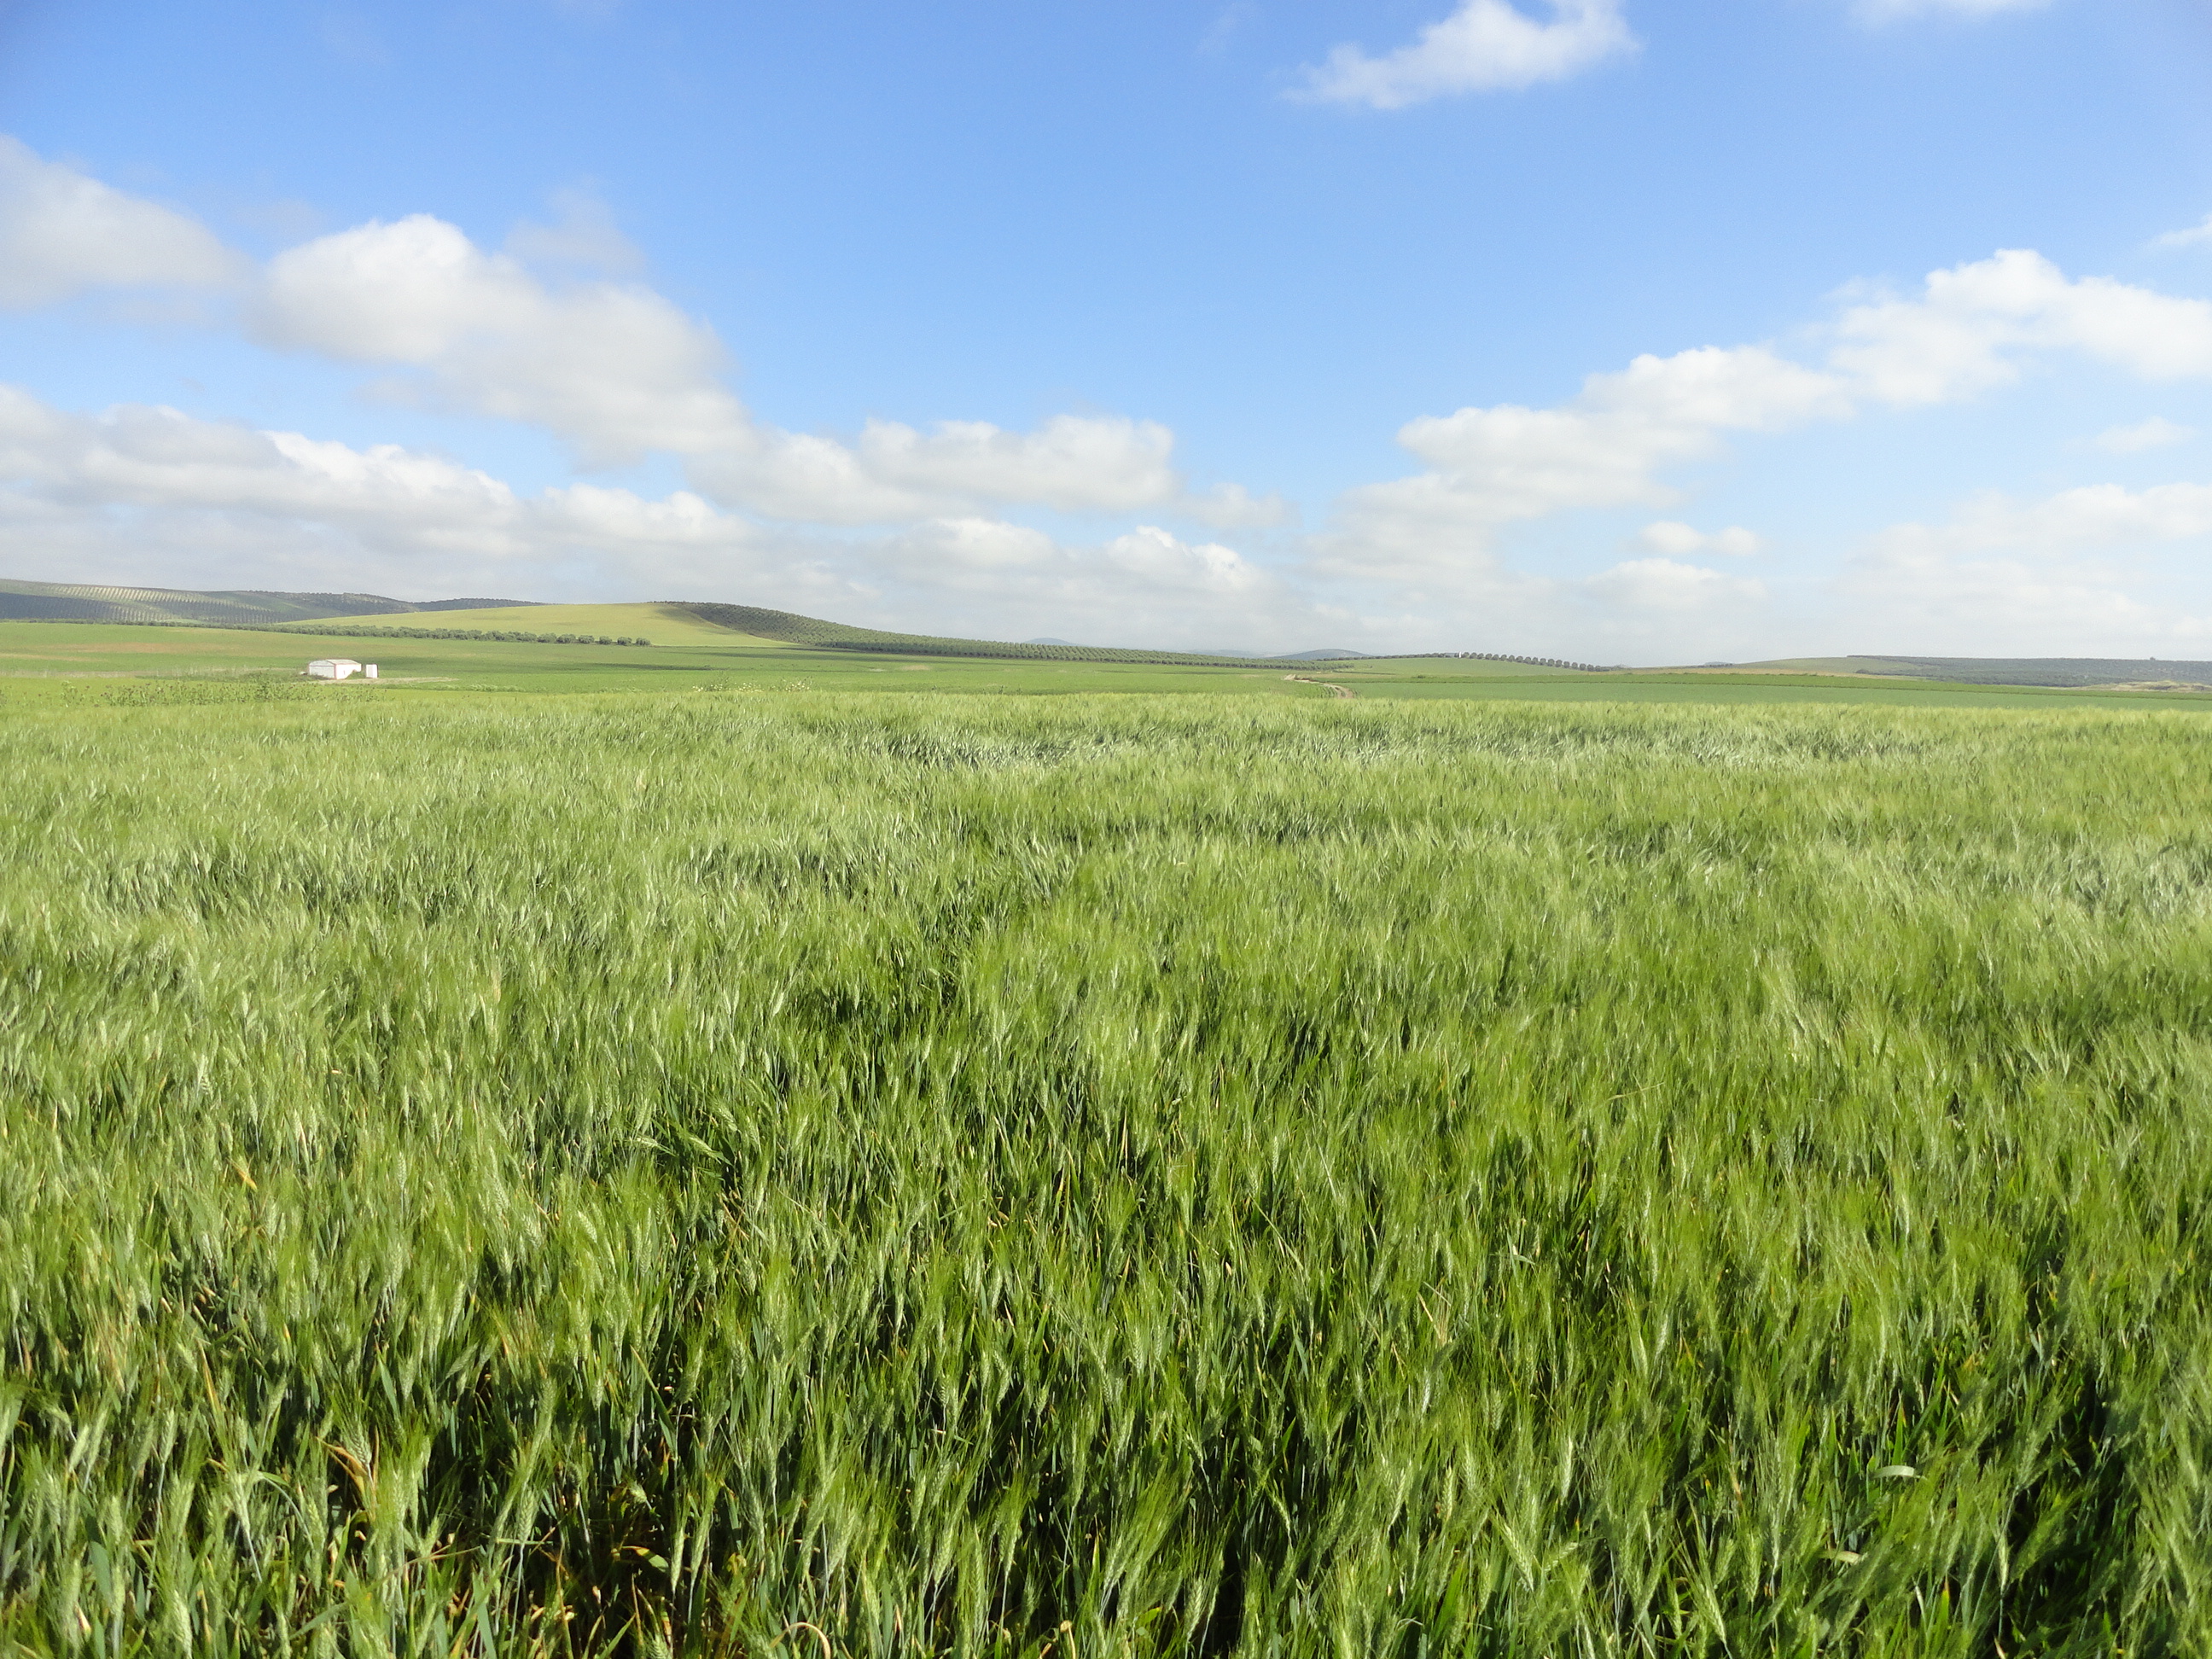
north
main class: Cropland
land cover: Durum wheat
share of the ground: > 75 %
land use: Agriculture (excluding fallow land and kitchen gardens)
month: April
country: ES
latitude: 37.6592
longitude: -4.6202
